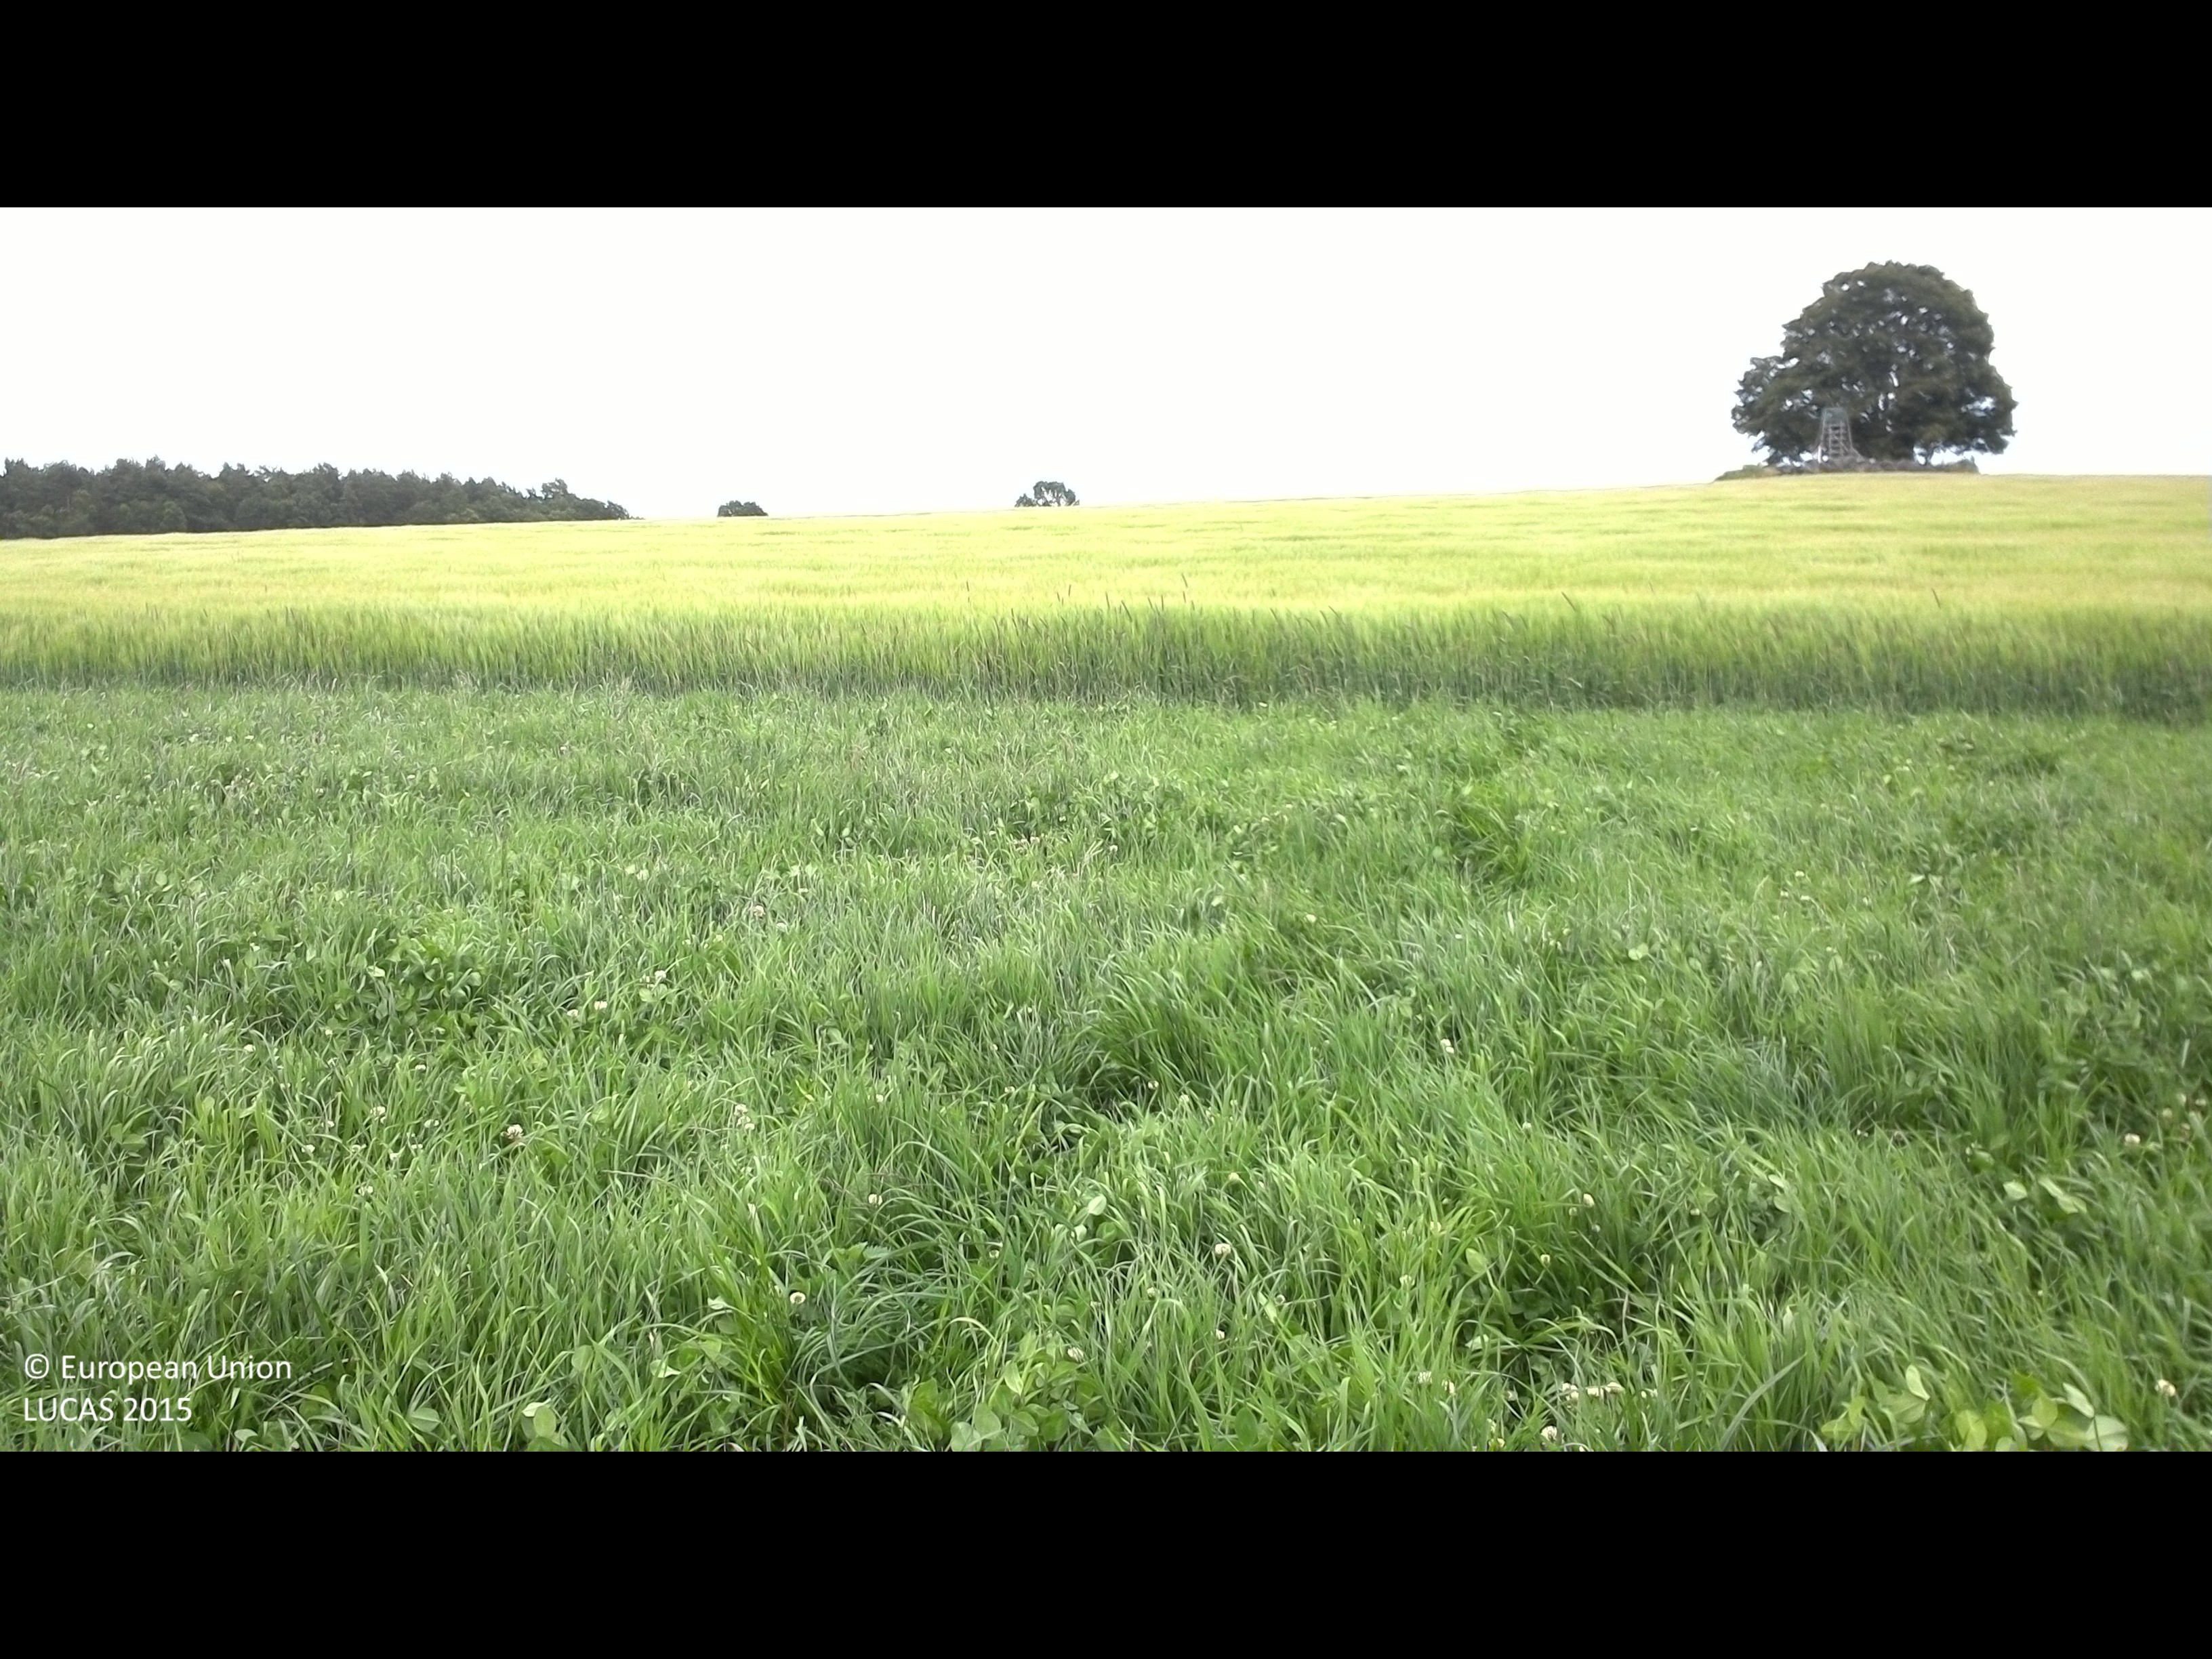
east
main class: Cropland
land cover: Other leguminous and mixtures for fodder
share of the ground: > 75 %
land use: Agriculture (excluding fallow land and kitchen gardens)
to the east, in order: Other leguminous and mixtures for fodder; Barley
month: June
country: SE
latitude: 56.5283
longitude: 16.1296
